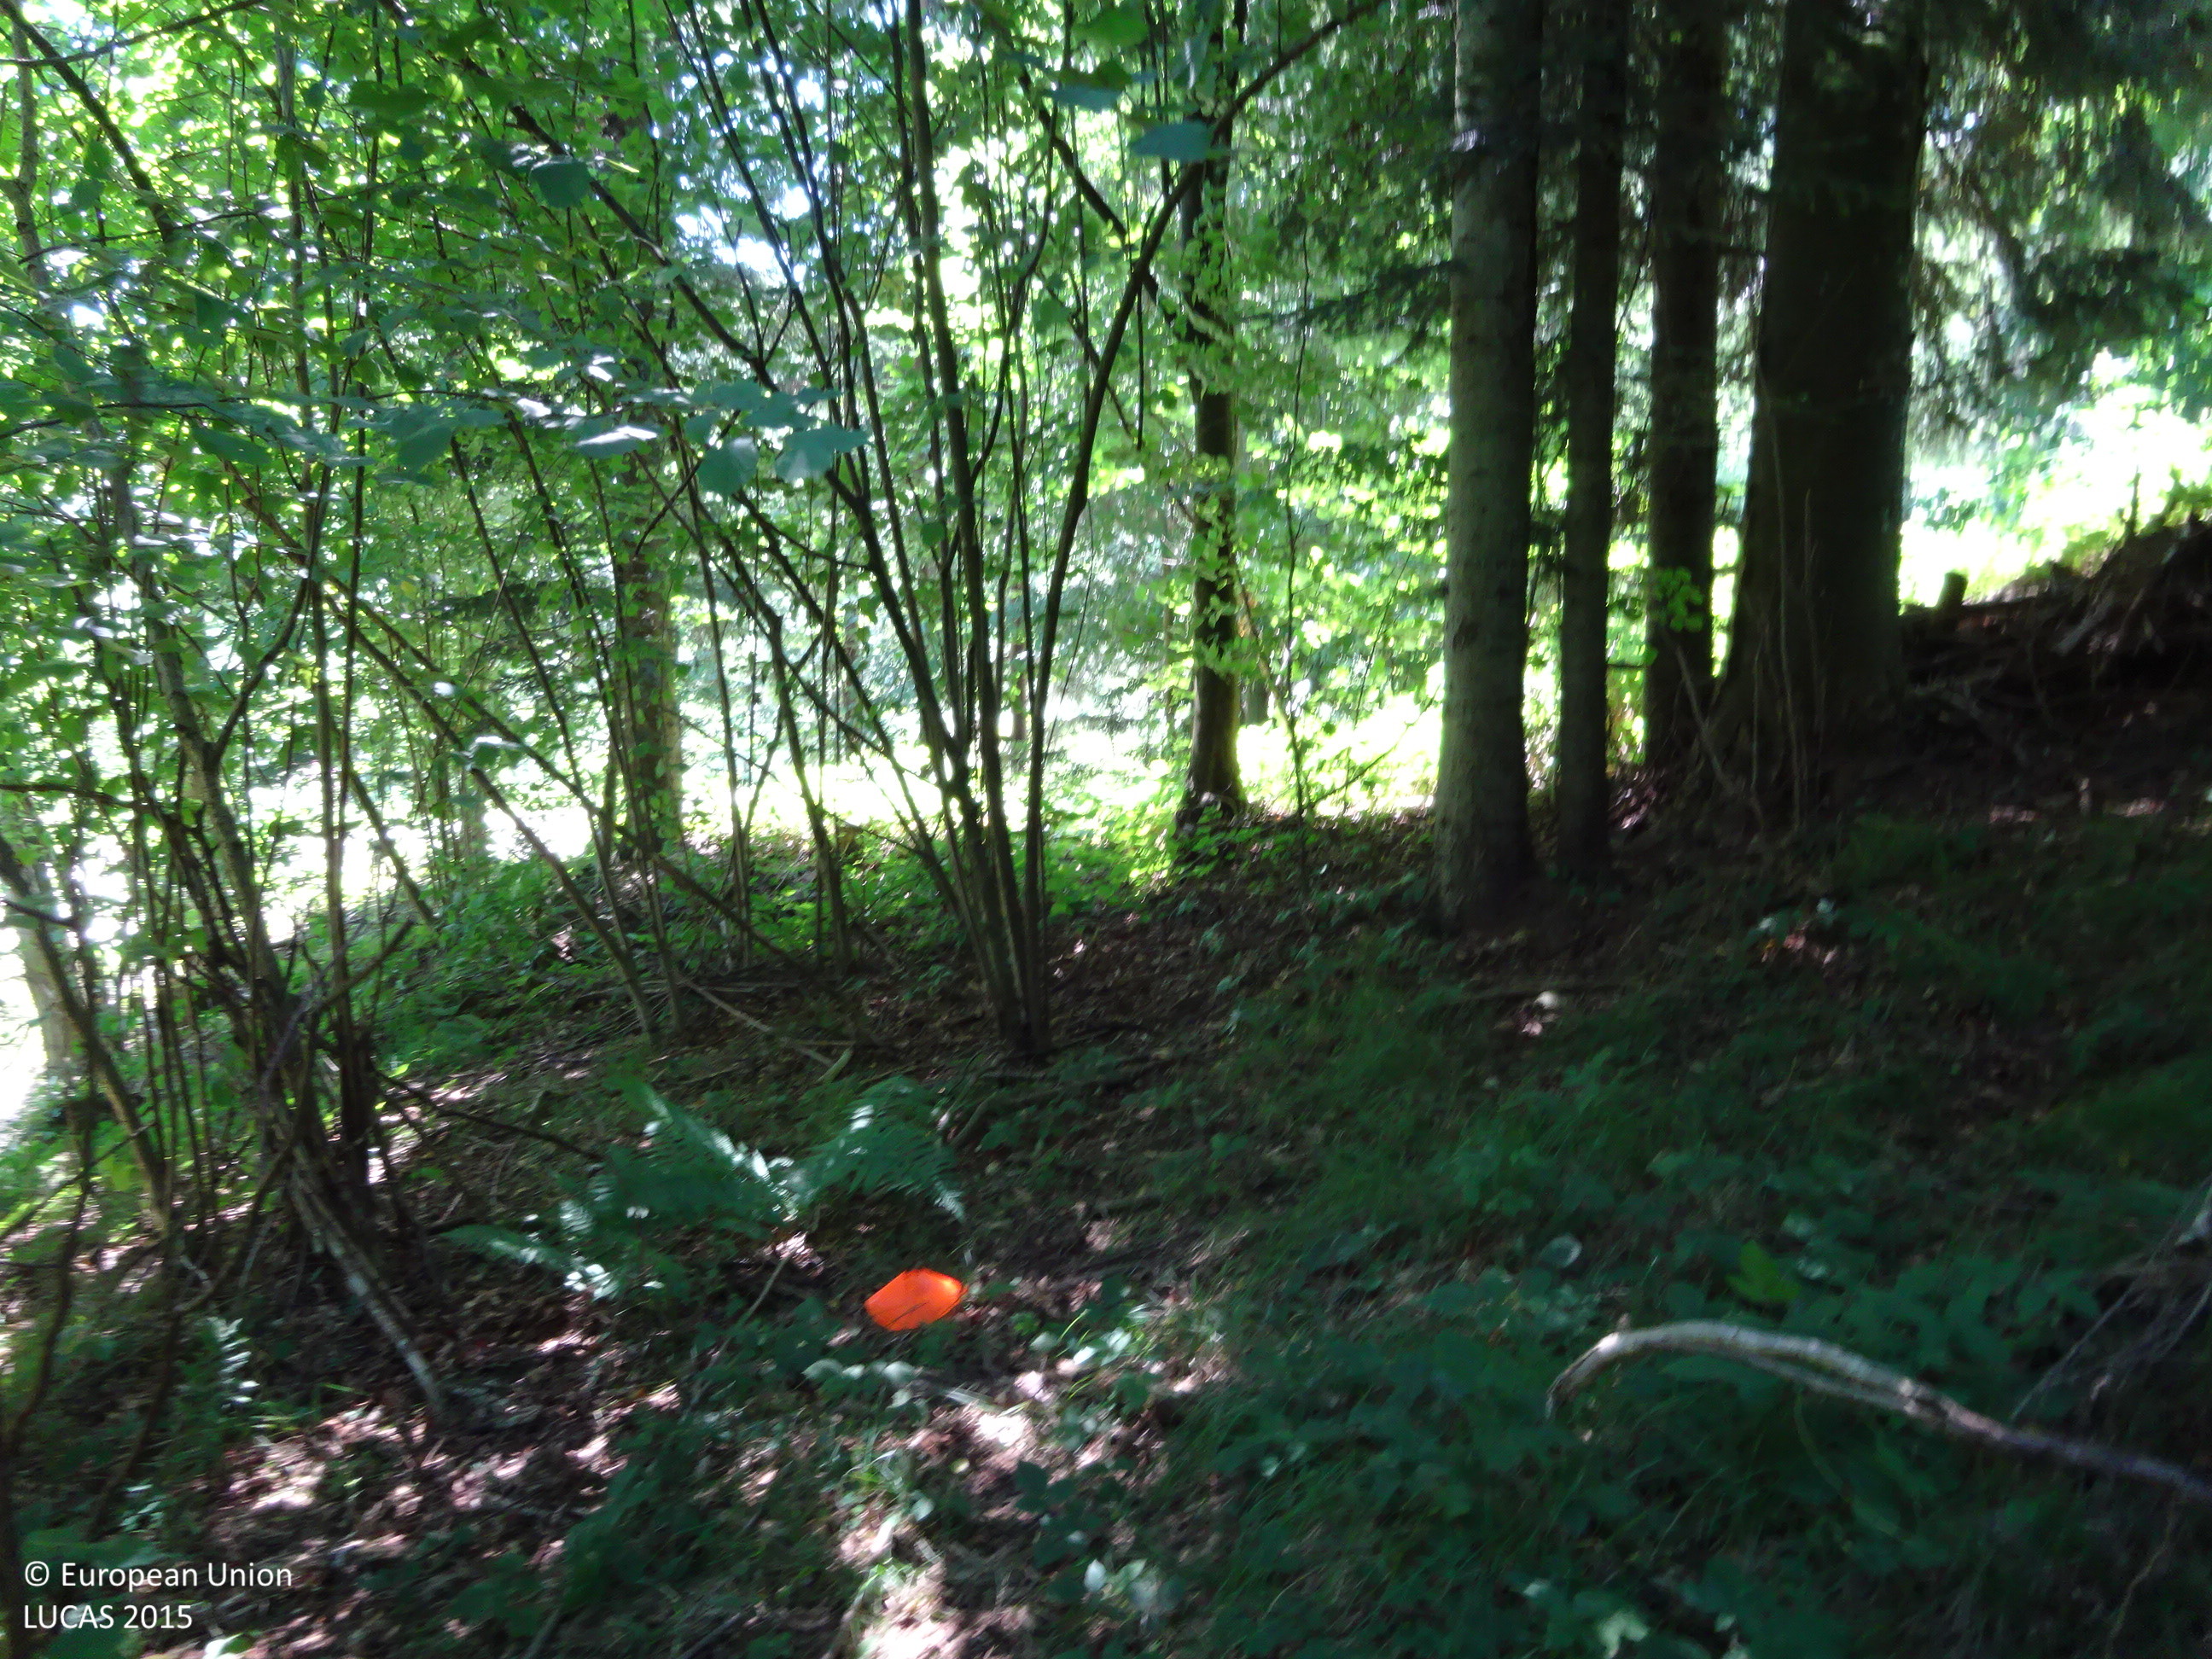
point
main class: Woodland
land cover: Other mixed woodland
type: alpine coniferous forest
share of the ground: > 75 %
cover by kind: shrubs 45 %, coniferous forest trees 30 %, broadleaved forest trees 25 %
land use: Forestry
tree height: > 5 m
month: August
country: AT
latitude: 47.4954
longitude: 16.0953
